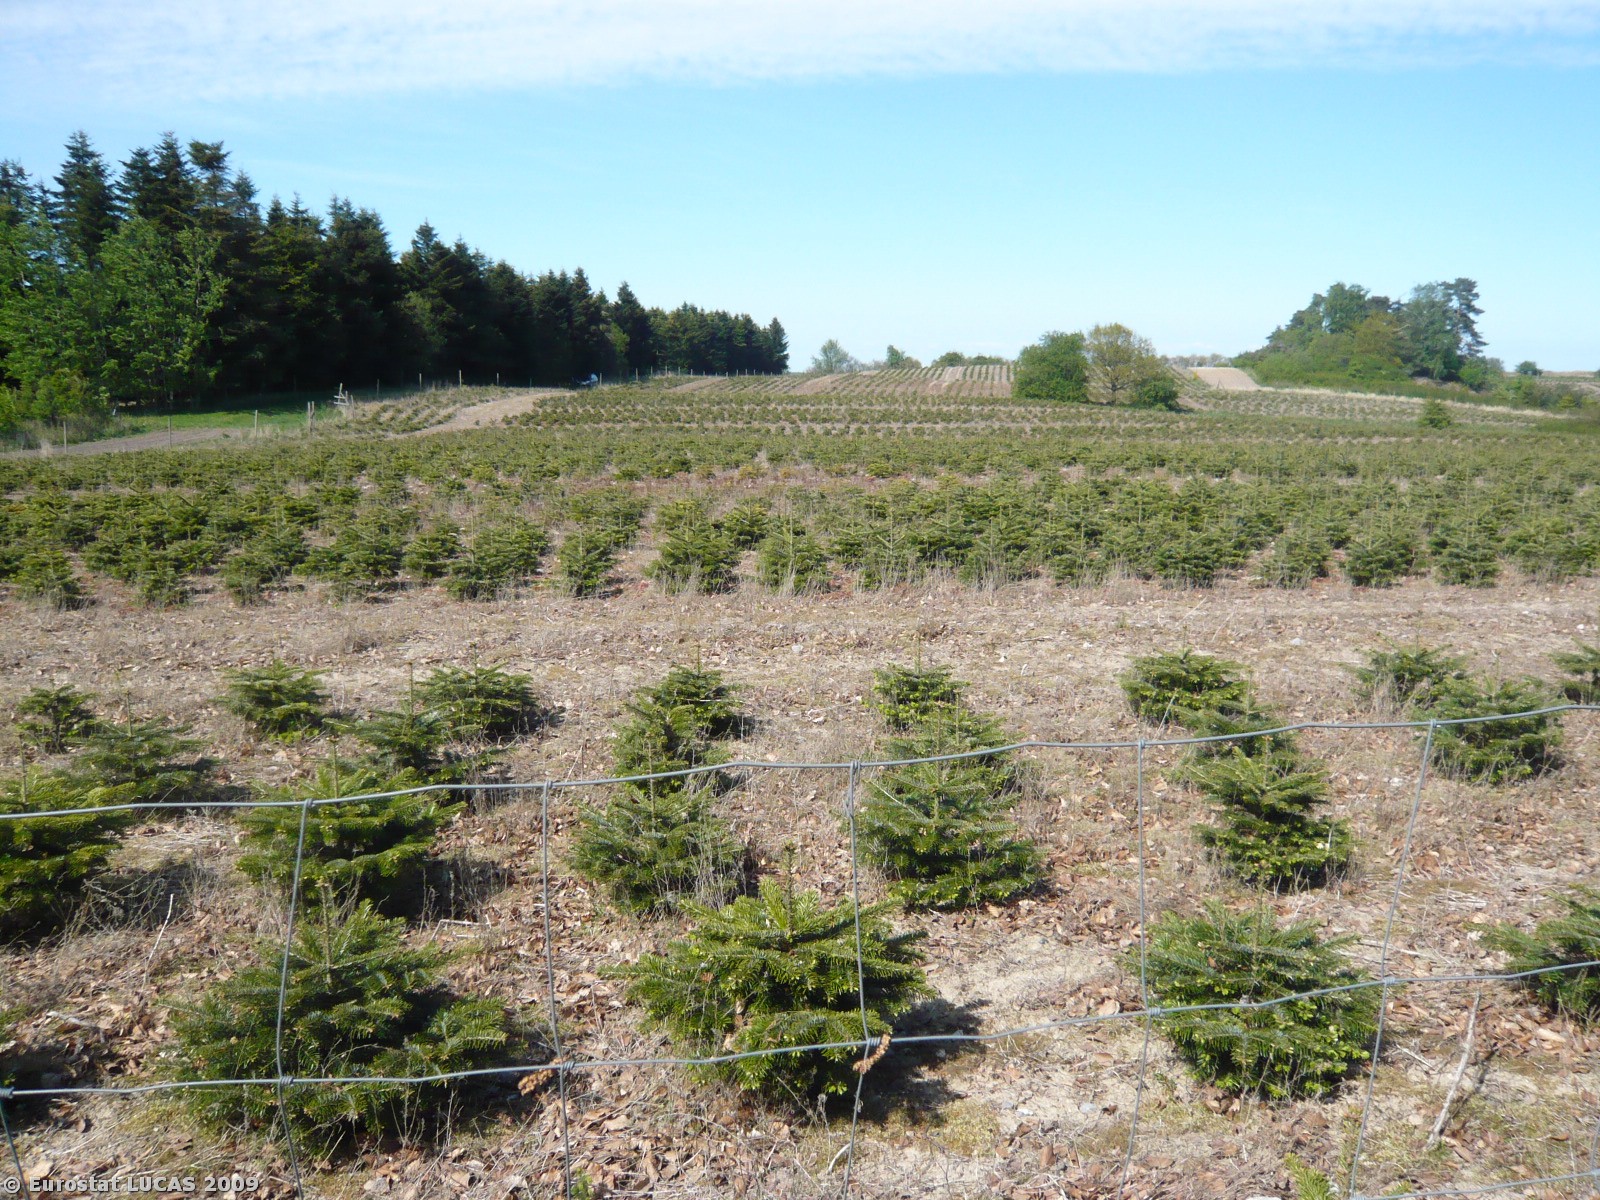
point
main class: Woodland
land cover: Coniferous woodland
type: plantations and self-sown exotic forest
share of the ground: 25 - 50 %
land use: Forestry
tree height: > 5 m
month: May
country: DK
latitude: 55.2557
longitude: 11.9652
